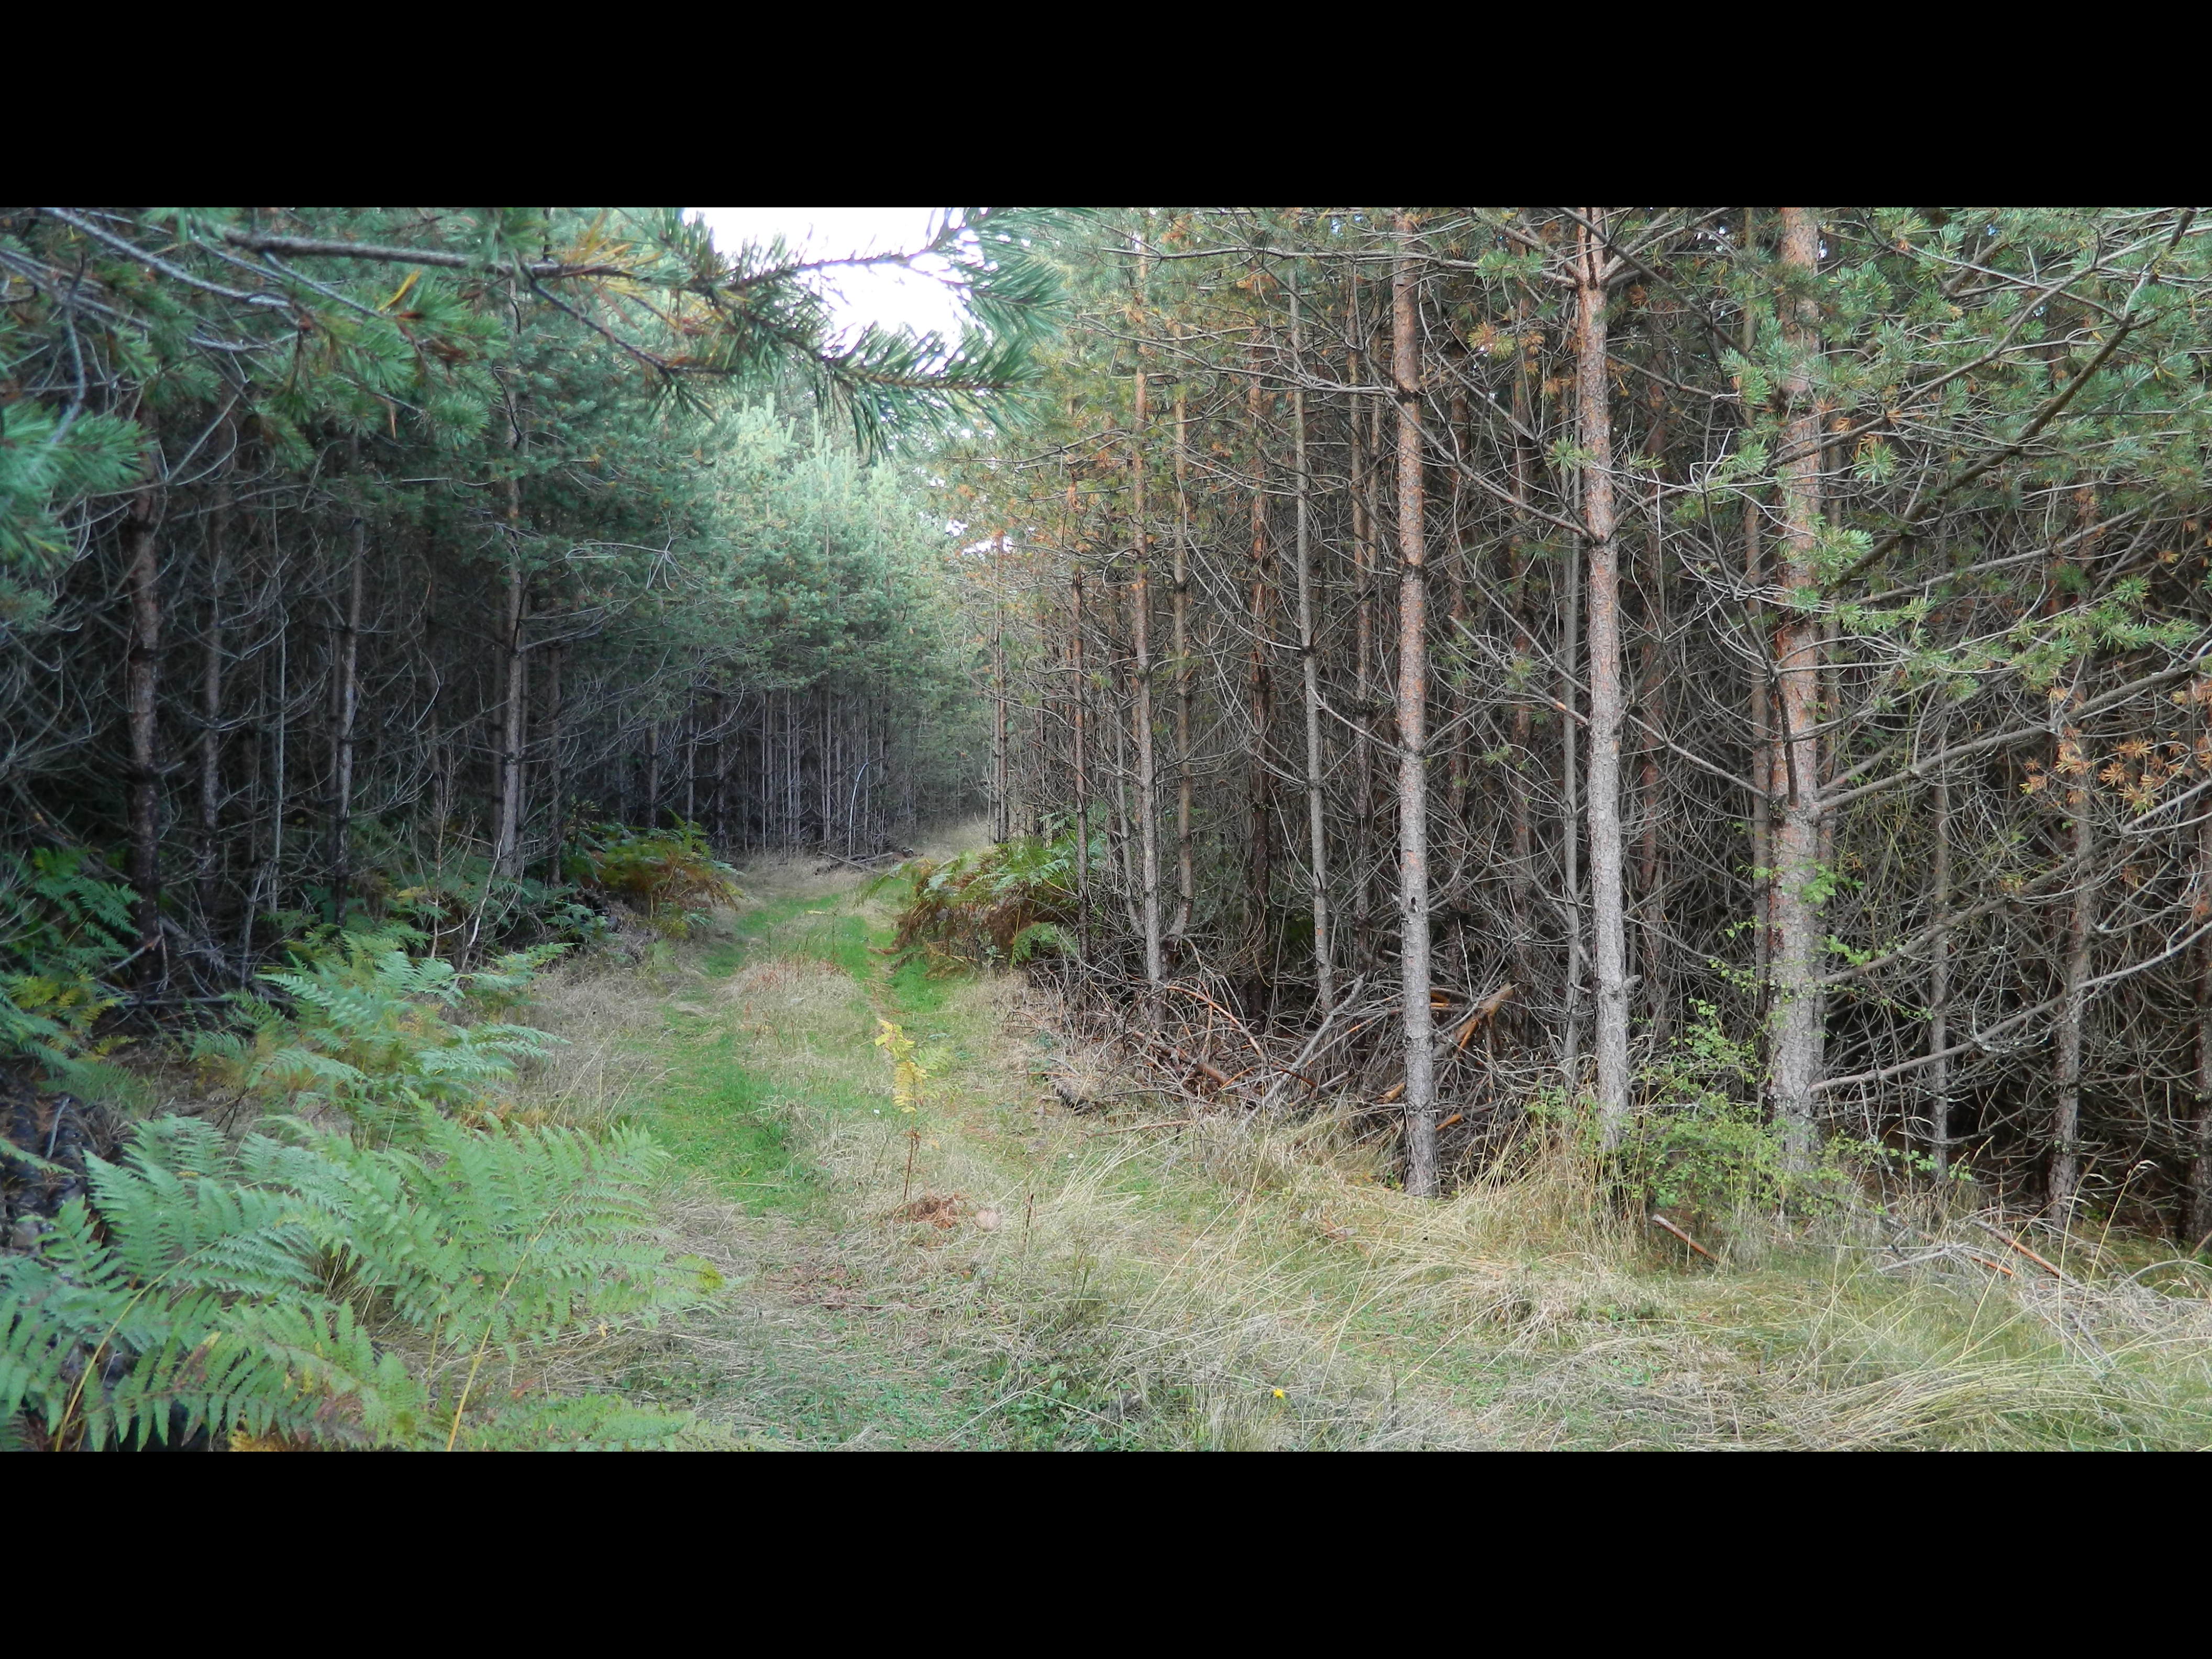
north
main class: Woodland
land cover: Pine dominated coniferous woodland
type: alpine coniferous forest
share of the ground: > 75 %
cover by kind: coniferous forest trees 100 %
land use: Forestry
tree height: > 5 m
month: October
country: BG
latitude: 41.7040
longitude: 24.9389
